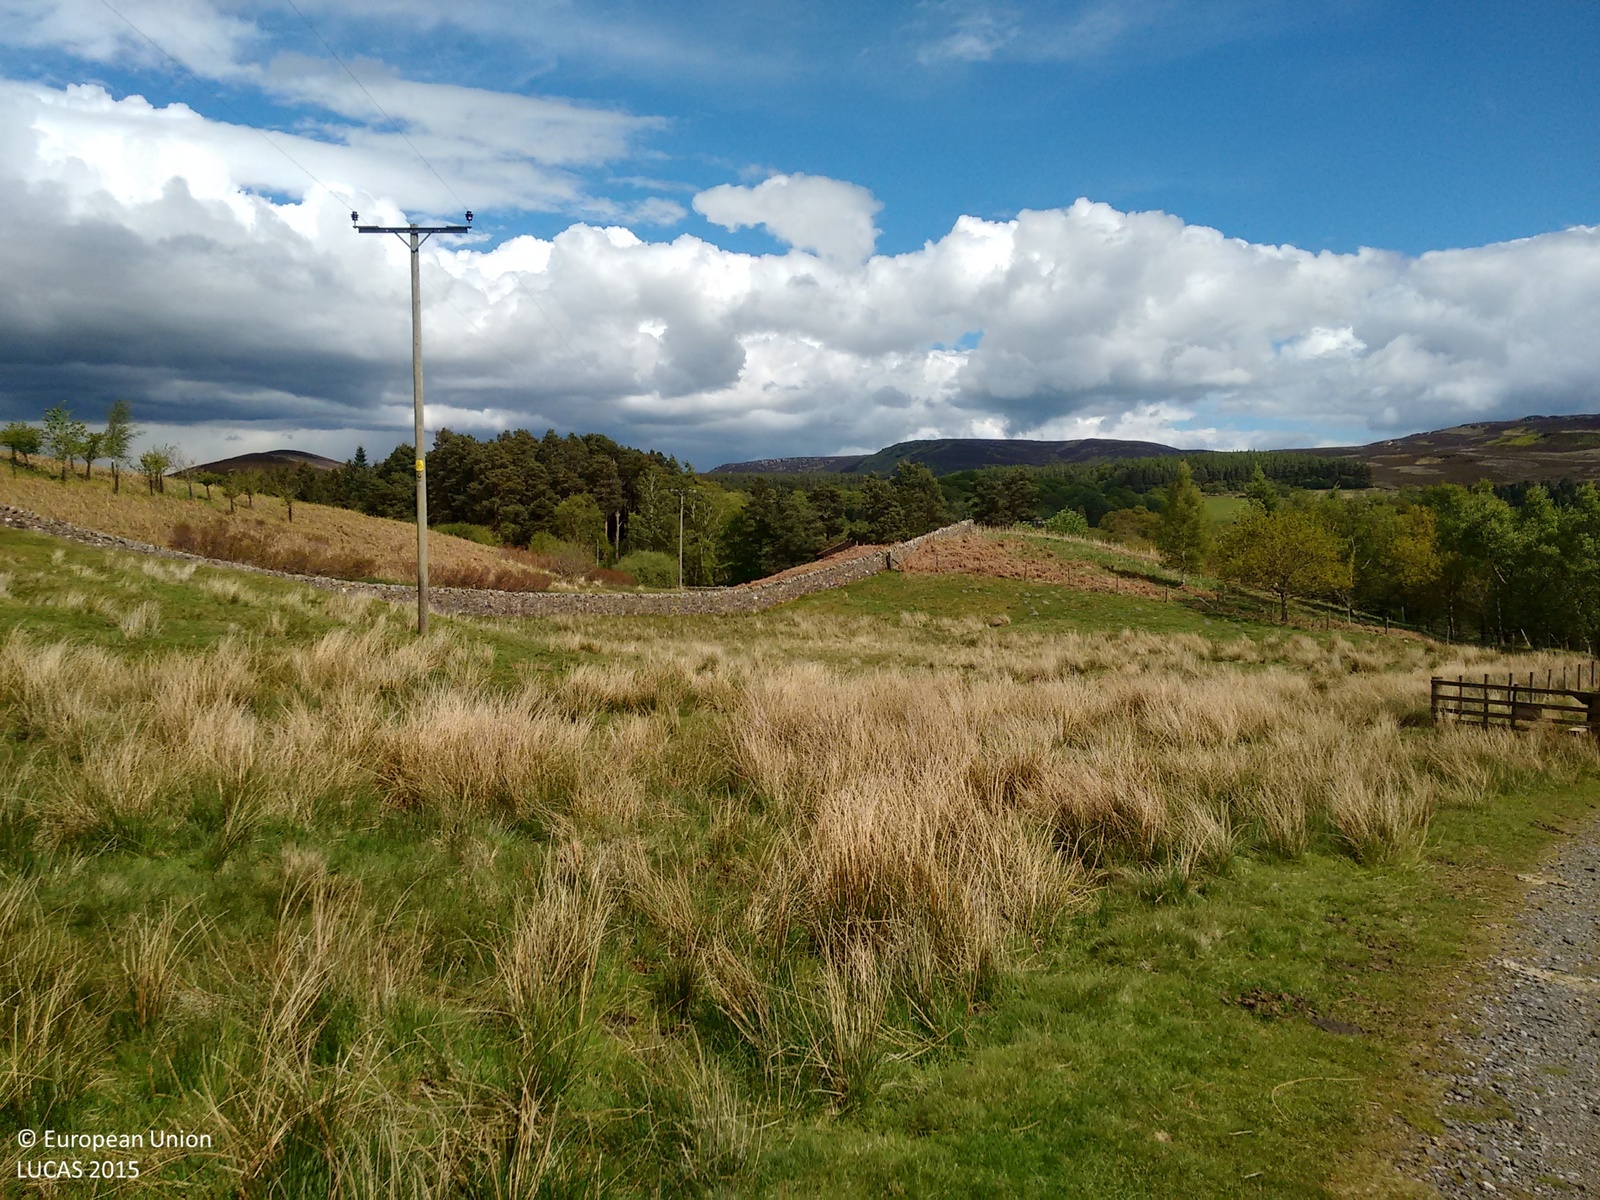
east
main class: Shrubland
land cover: Shrubland without tree cover
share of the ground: > 75 %
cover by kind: shrubs 80 %, herbaceous plants 20 %
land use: Community services
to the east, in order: Shrubland without tree cover
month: May
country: GB
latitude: 55.2880
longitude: -2.0691
